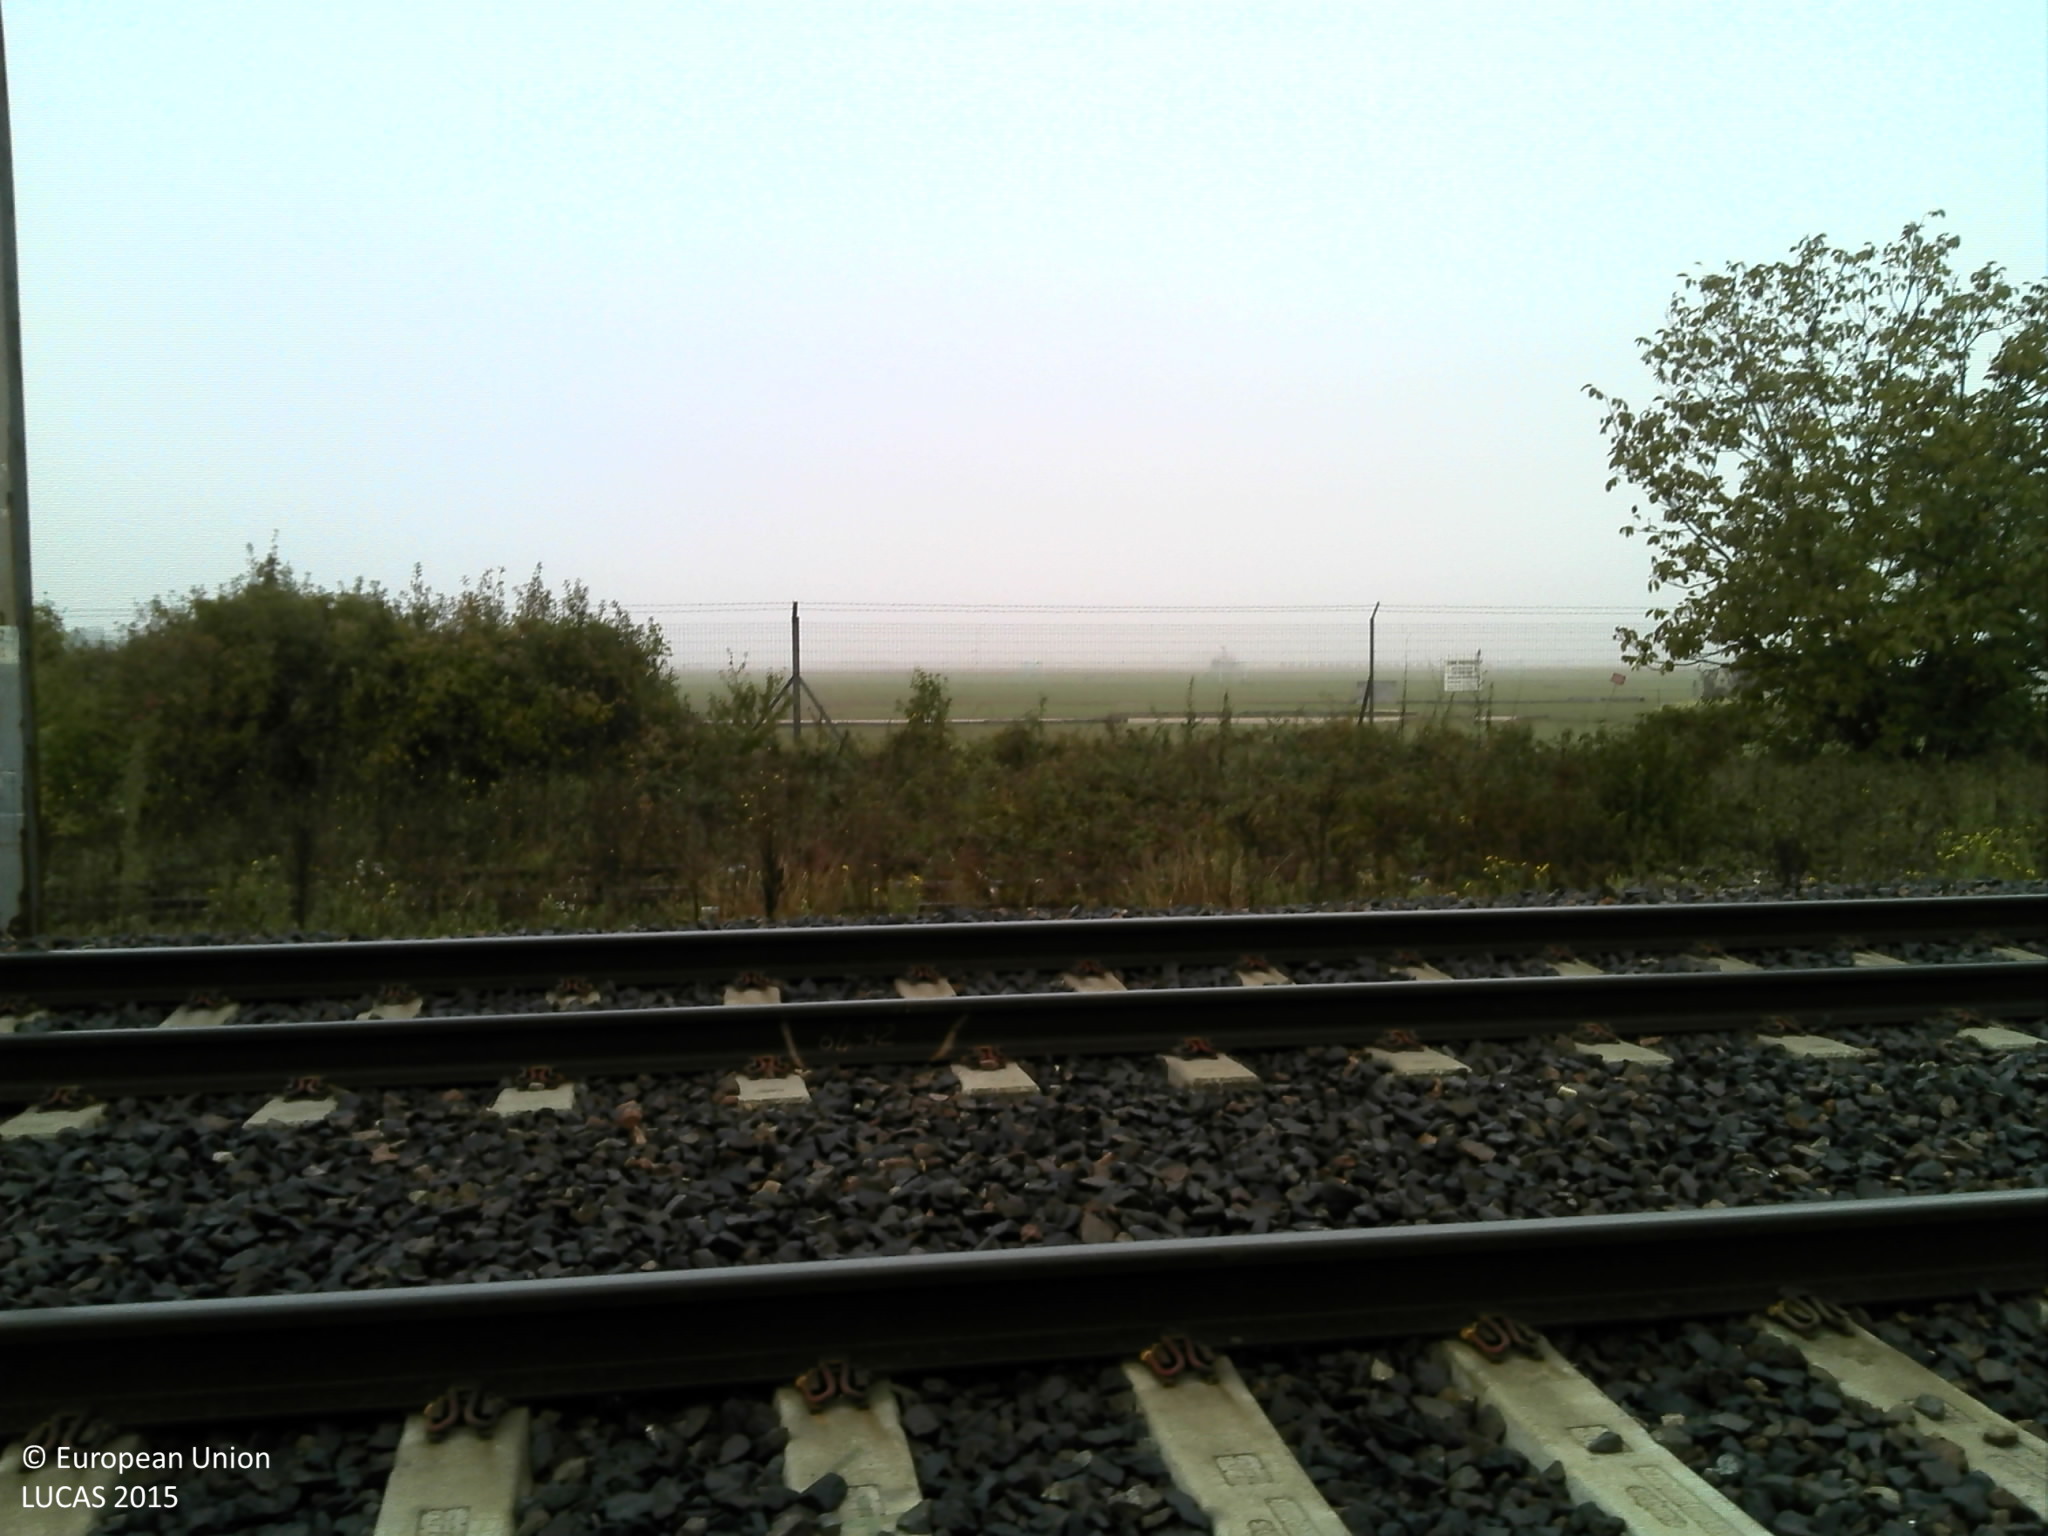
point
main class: Grassland
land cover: Grassland with sparse tree/shrub cover
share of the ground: > 75 %
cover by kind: herbaceous plants 95 %, broadleaved forest trees 5 %
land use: Air transport
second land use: Community services
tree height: > 5 m
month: October
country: FR
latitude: 45.9792
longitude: 5.3439
